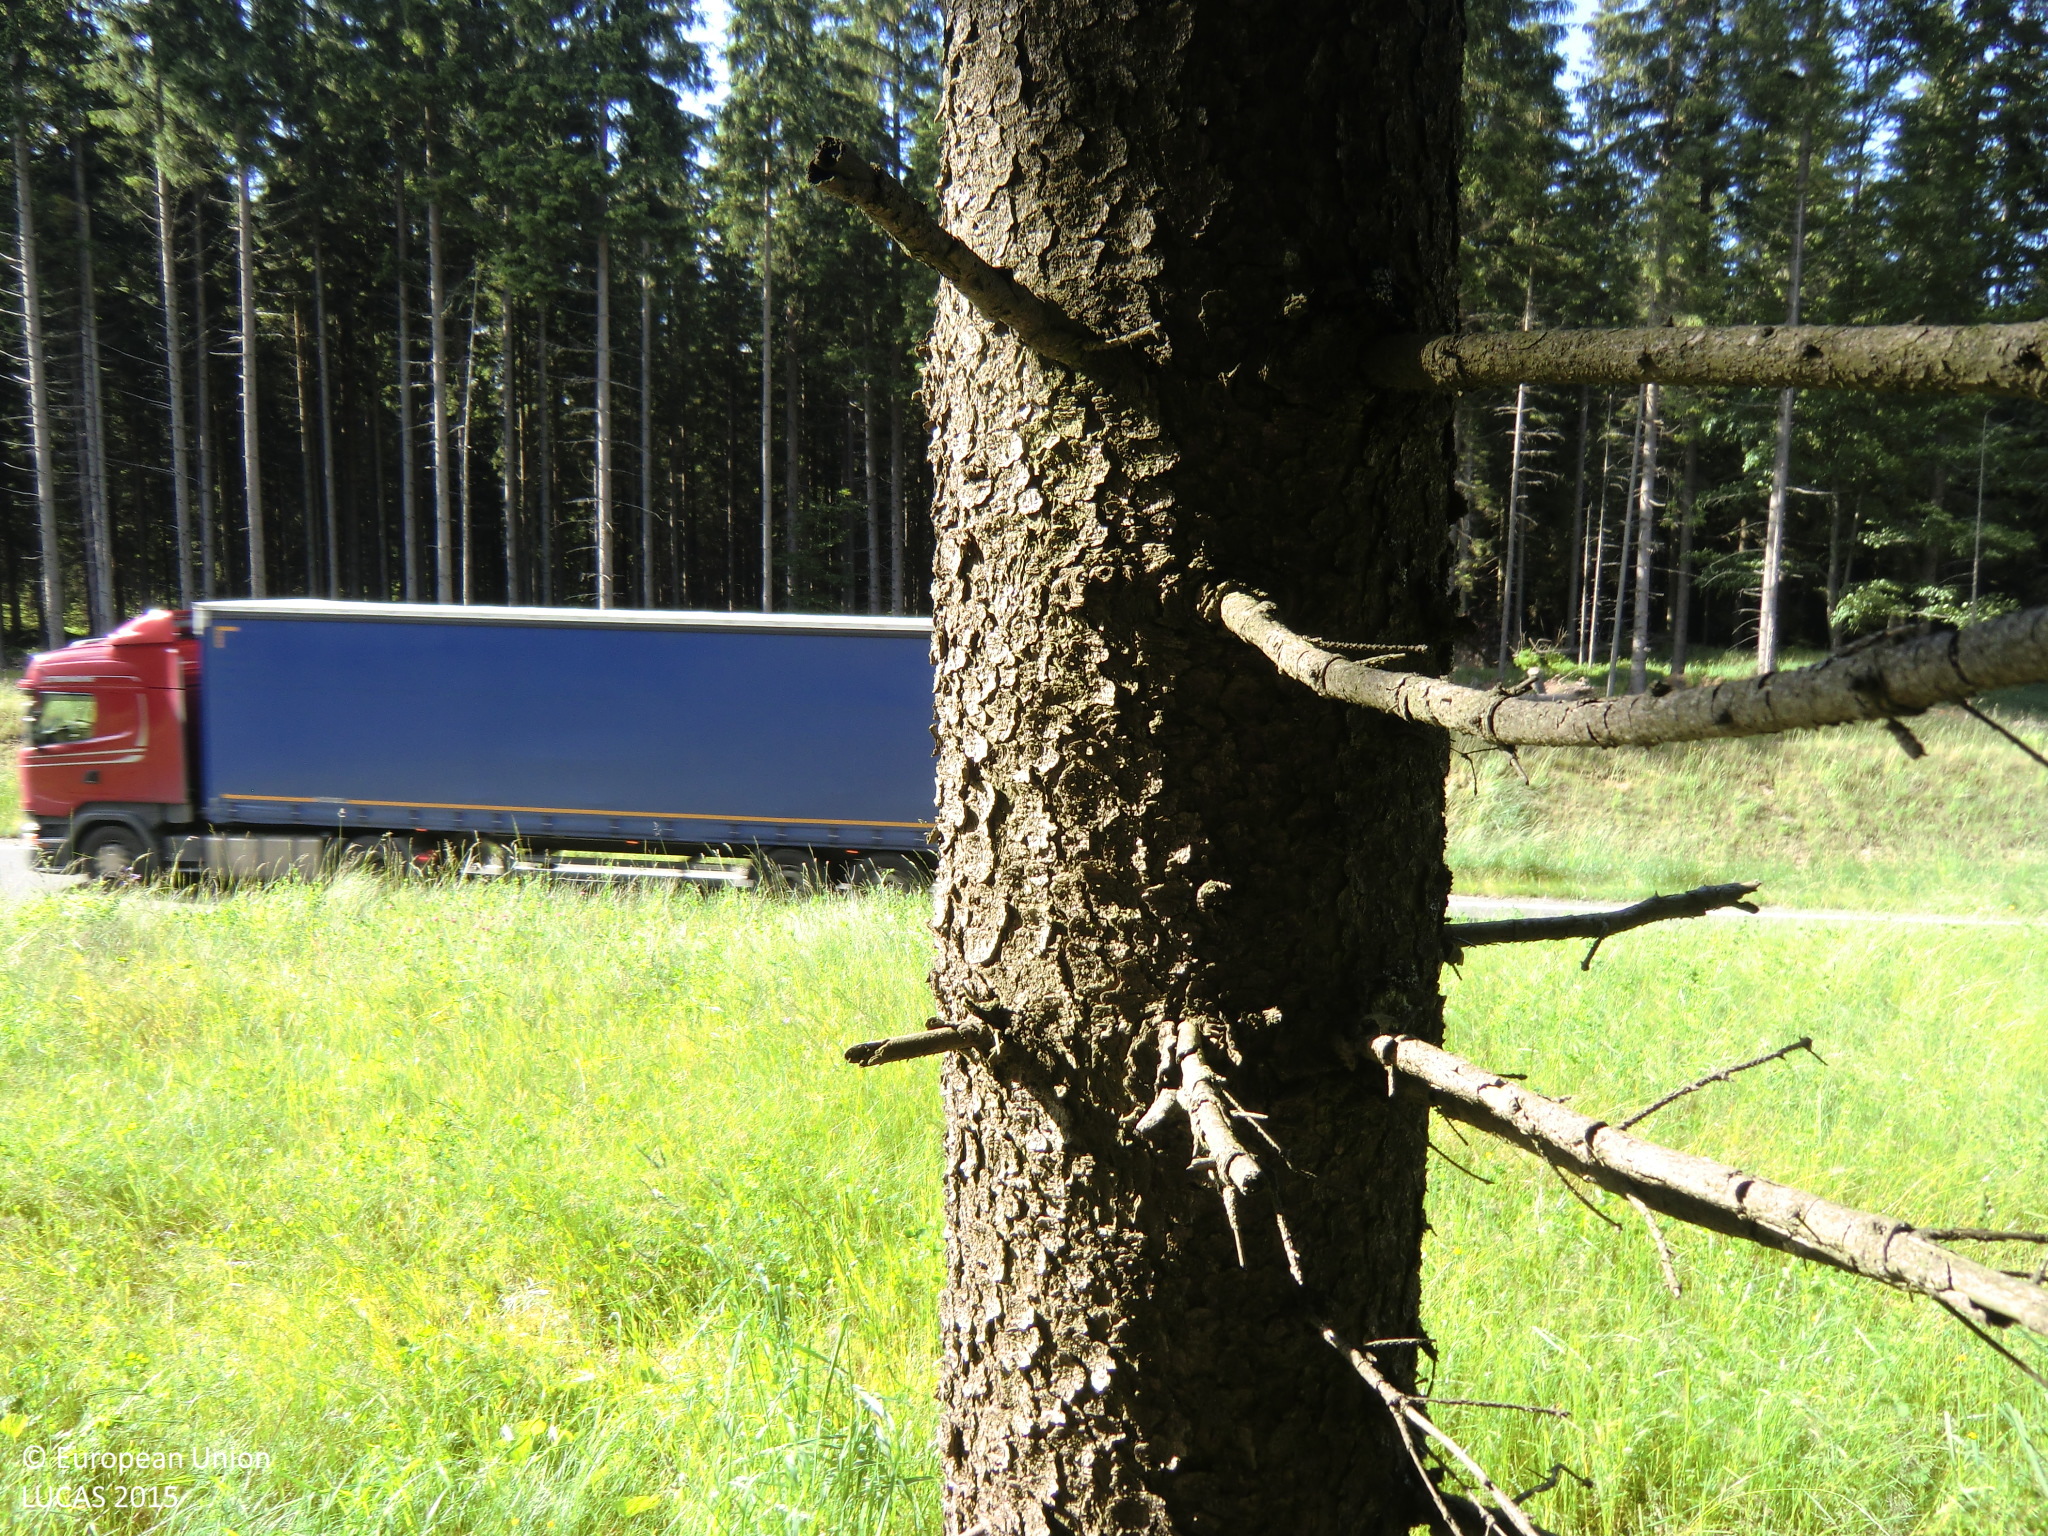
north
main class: Woodland
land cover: Spruce dominated coniferous woodland
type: hemiboreal forest and nemoral coniferous forest and mixed broadleaved-coniferous forest
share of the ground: > 75 %
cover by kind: coniferous forest trees 80 %, herbaceous plants 20 %
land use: Forestry
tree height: > 5 m
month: June
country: AT
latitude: 48.5558
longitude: 14.7025
